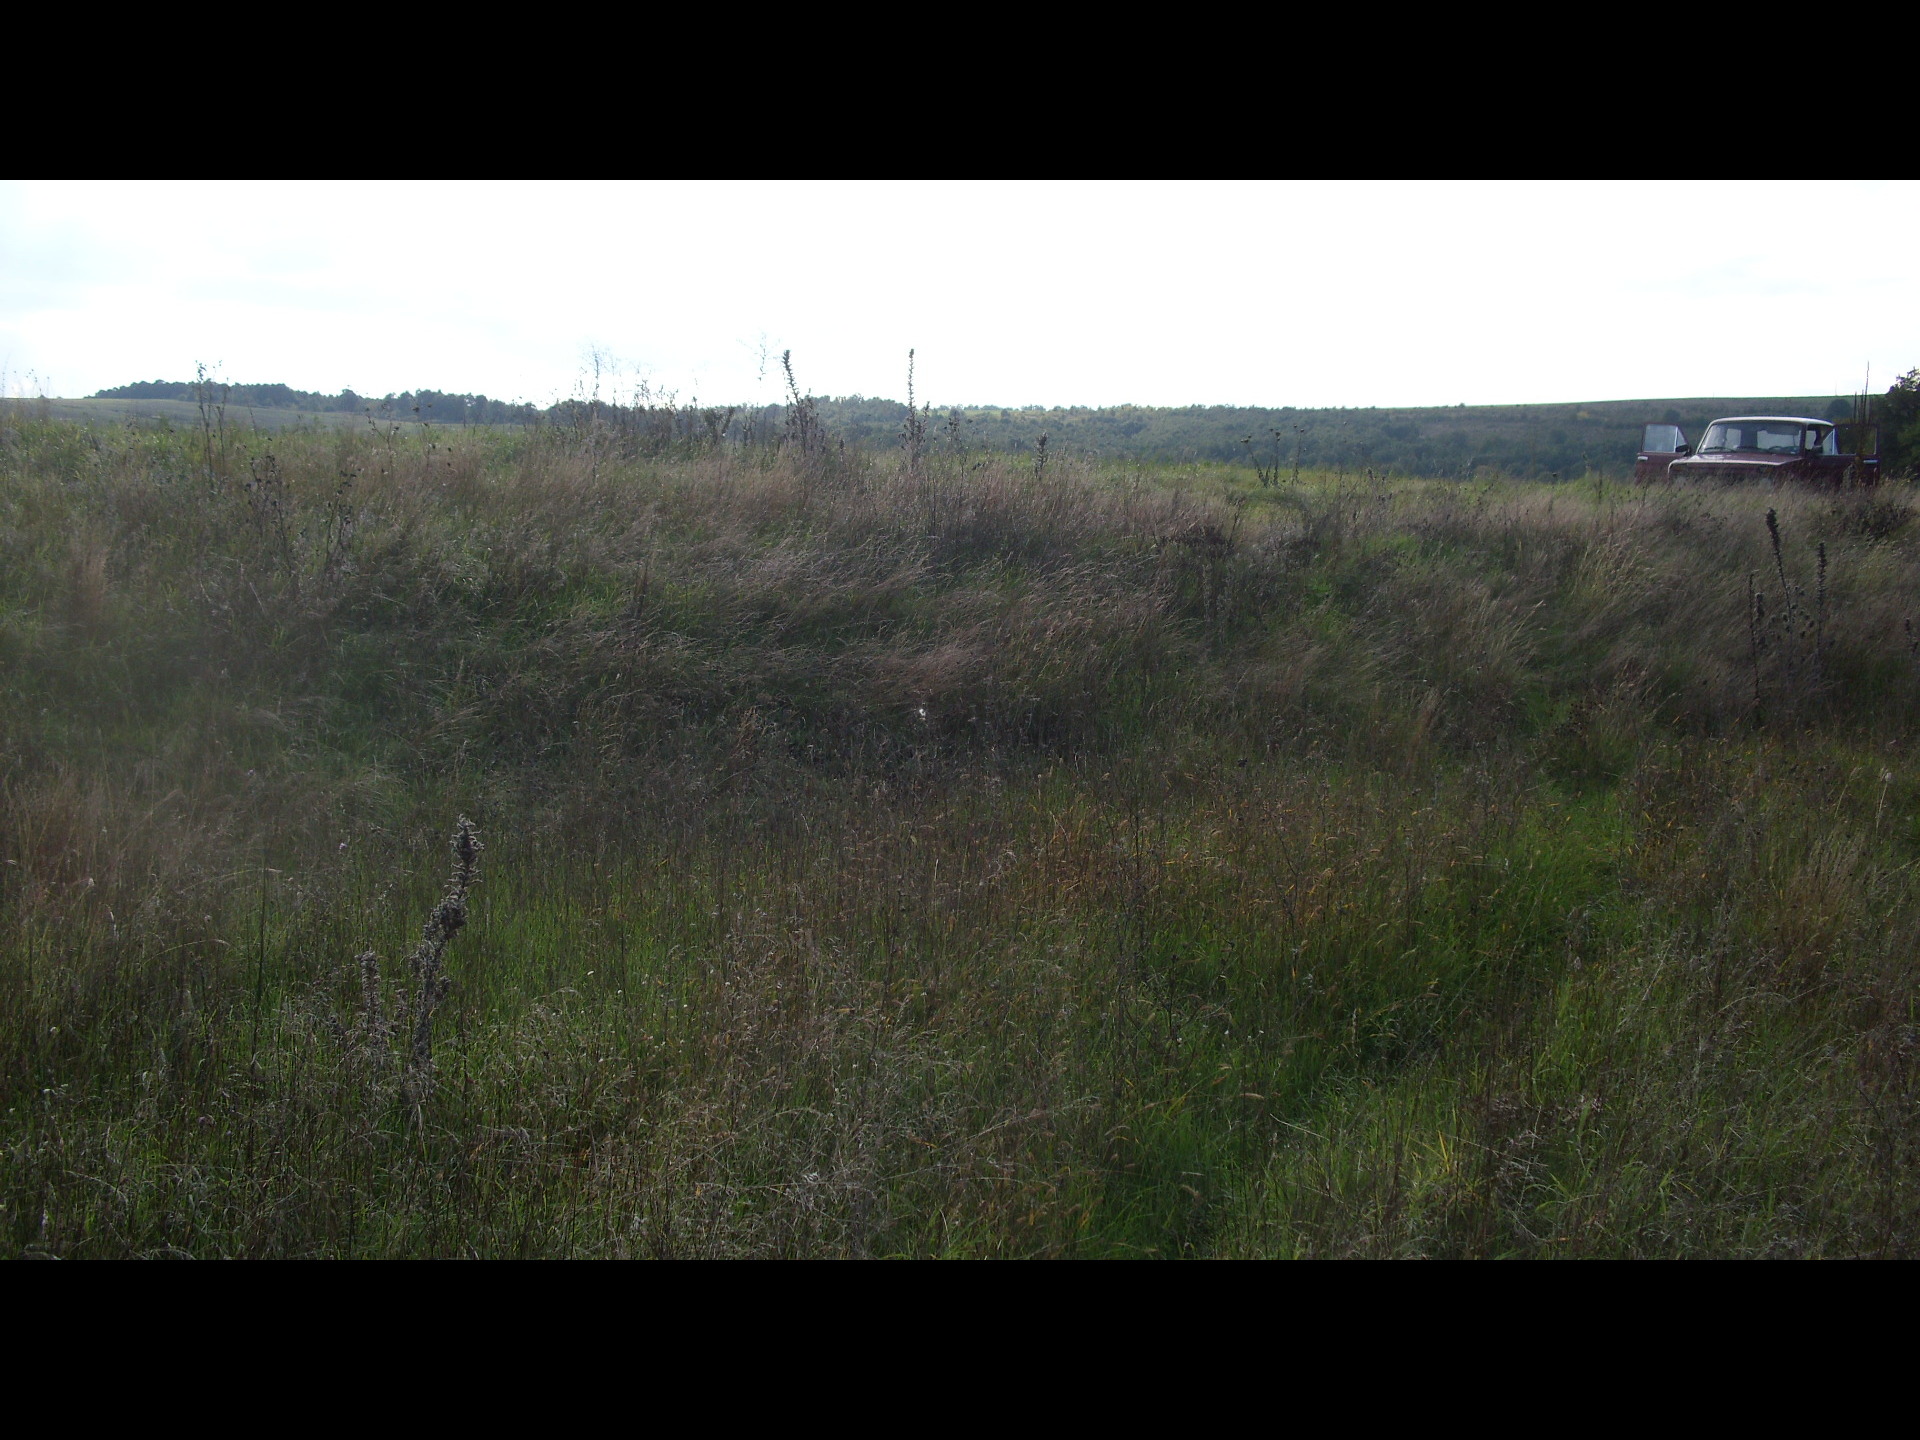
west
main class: Woodland
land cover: Broadleaved woodland
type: mesophytic deciduous forest
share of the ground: > 75 %
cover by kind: broadleaved forest trees 100 %
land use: Forestry
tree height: < 5 m
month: October
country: BG
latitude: 43.4002
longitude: 23.2890
